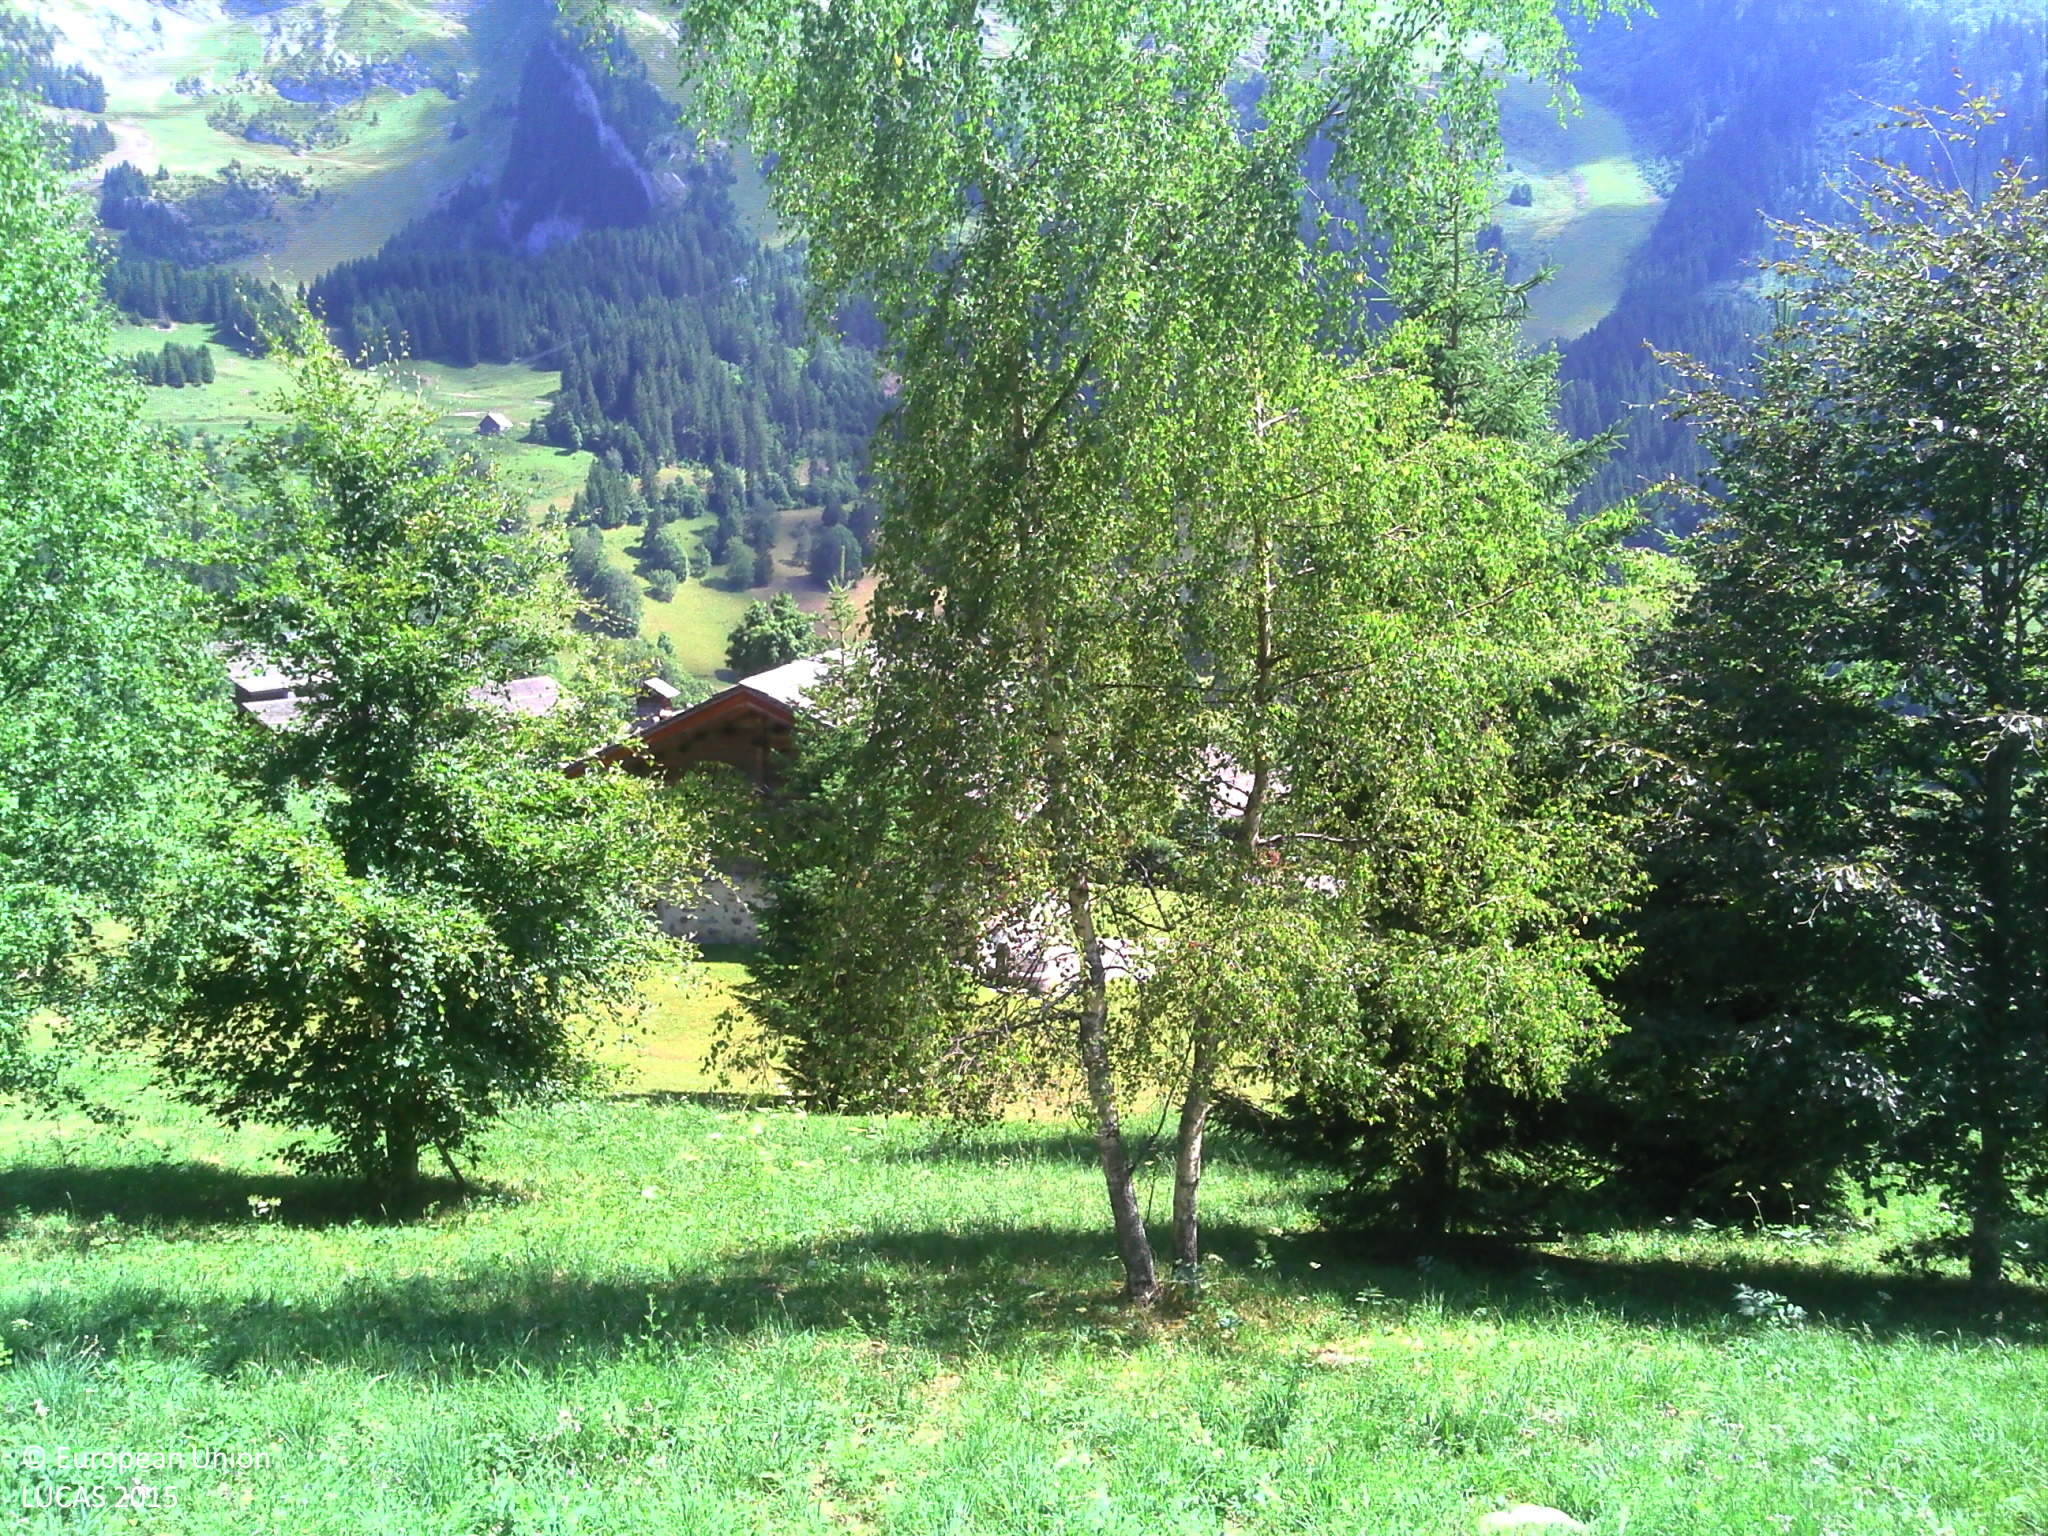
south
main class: Grassland
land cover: Grassland with sparse tree/shrub cover
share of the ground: > 75 %
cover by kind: herbaceous plants 95 %, broadleaved forest trees 5 %
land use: Agriculture (excluding fallow land and kitchen gardens)
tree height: > 5 m
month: July
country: FR
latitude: 45.9139
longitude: 6.4585
